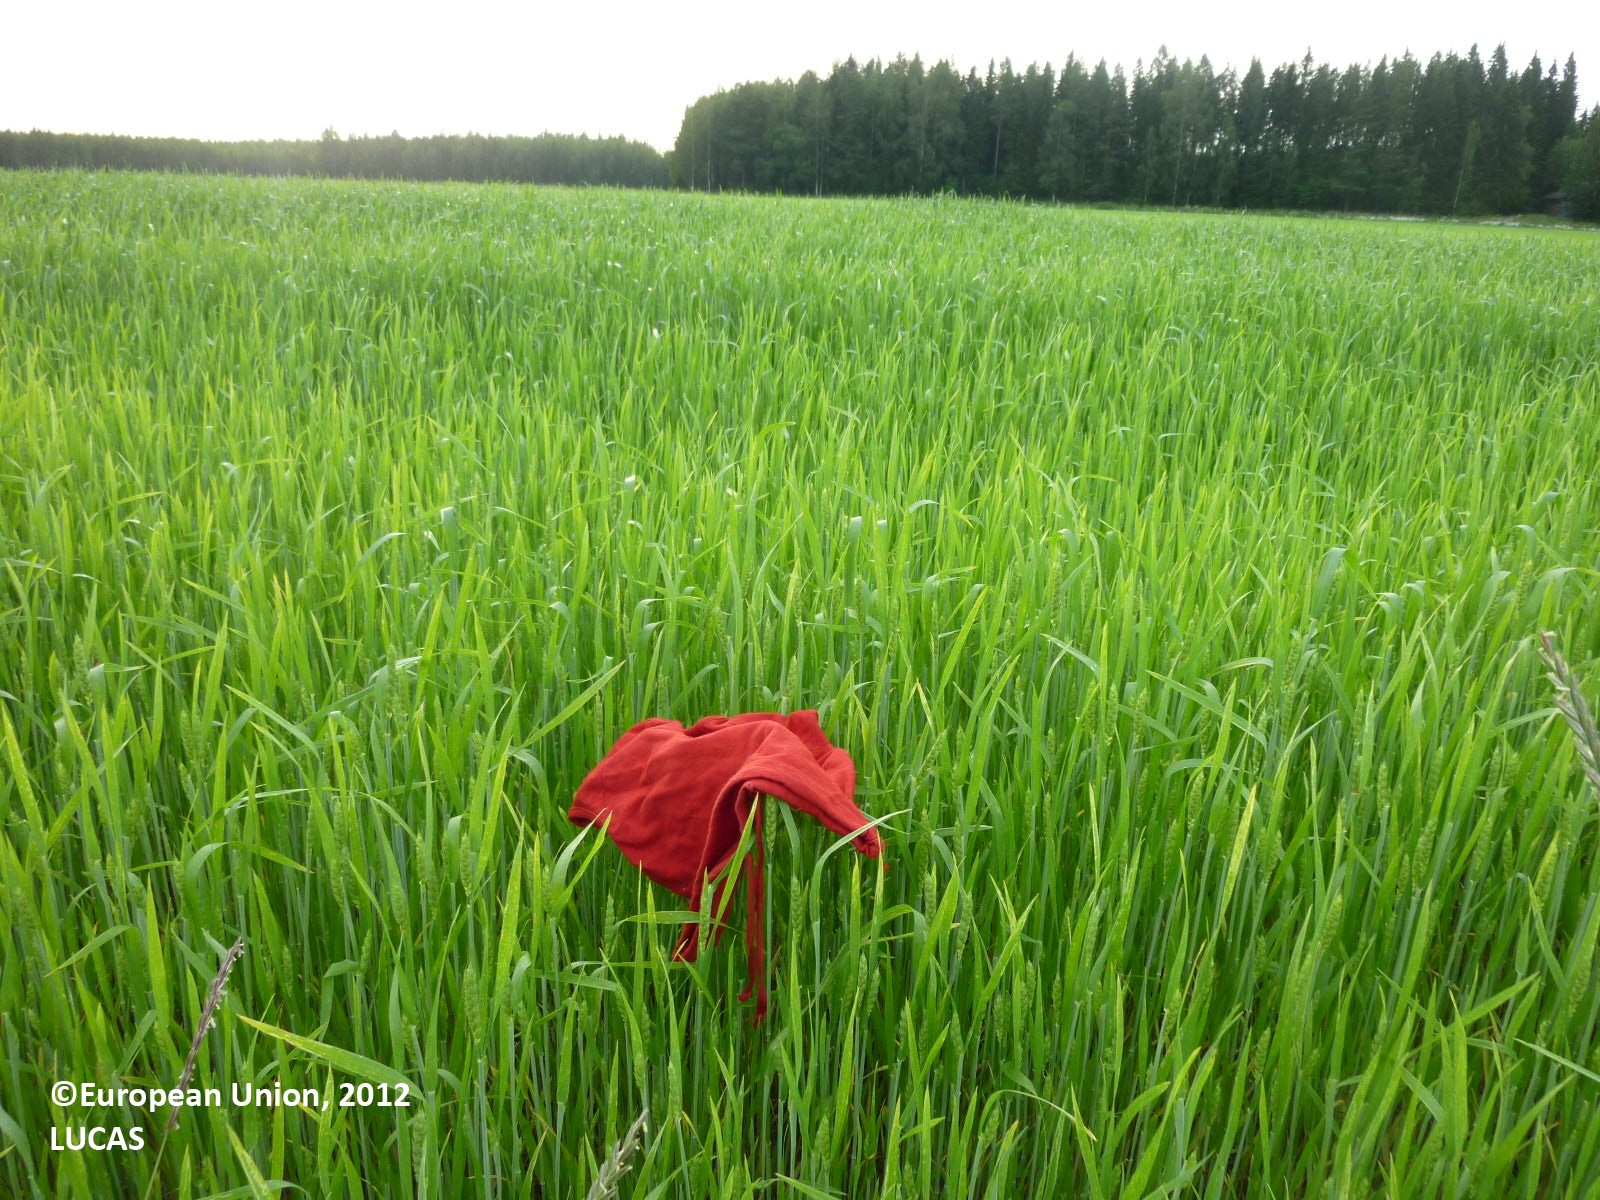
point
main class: Cropland
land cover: Common wheat
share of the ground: > 75 %
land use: Agriculture (excluding fallow land and kitchen gardens)
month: July
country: FI
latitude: 61.4156
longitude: 22.0299
